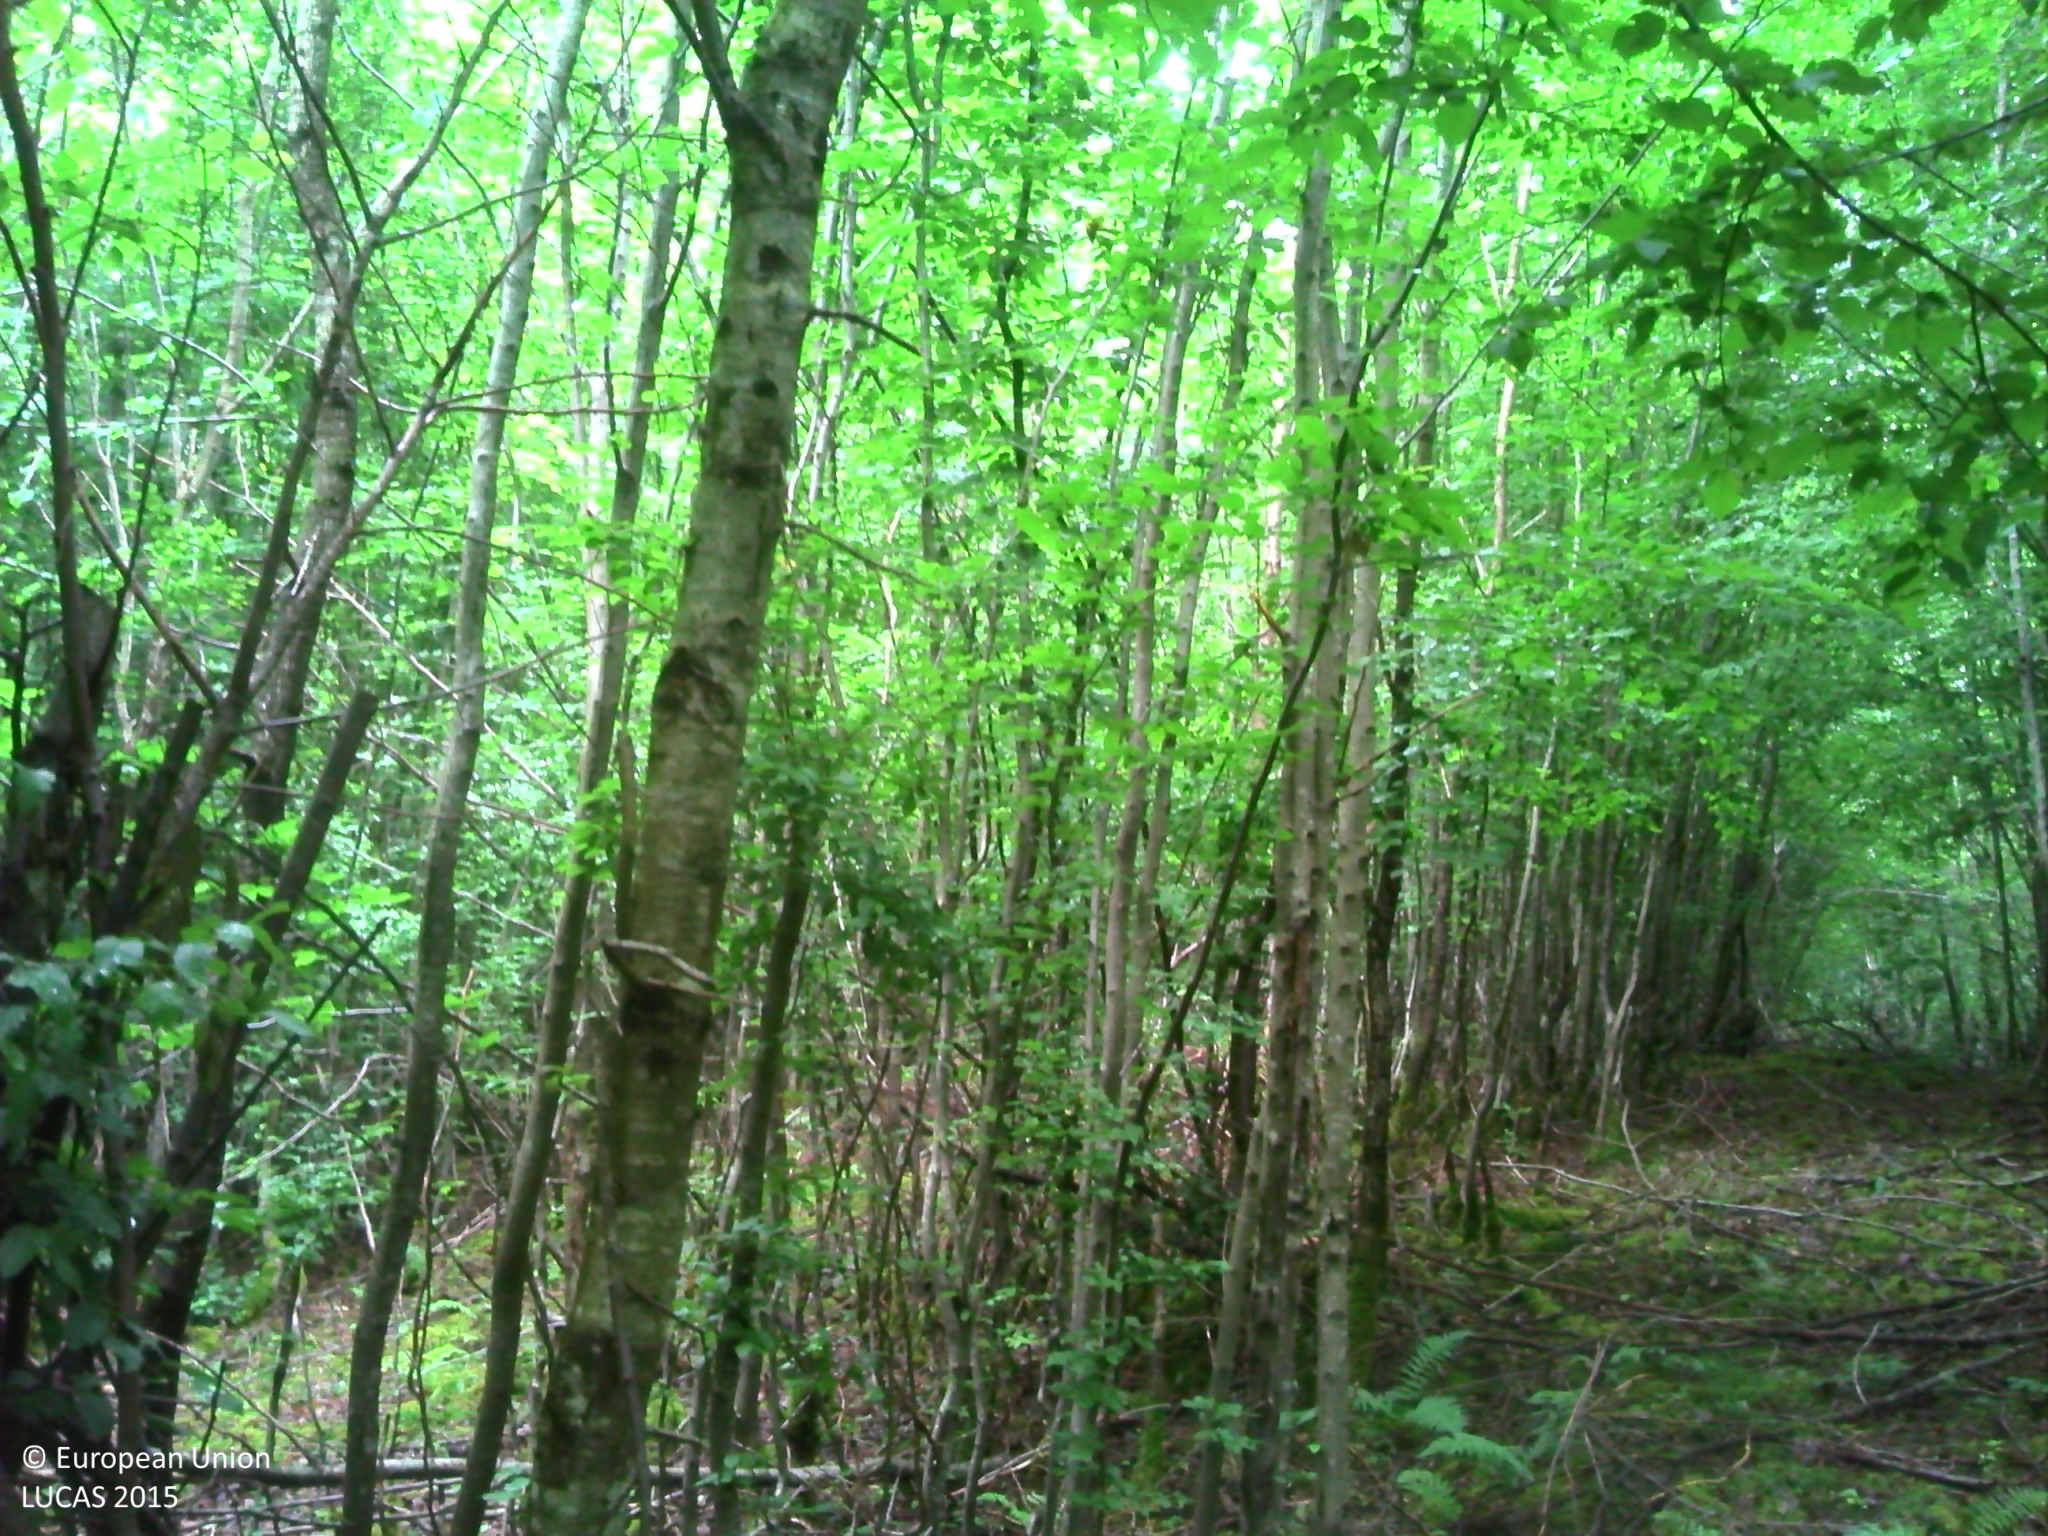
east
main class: Woodland
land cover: Broadleaved woodland
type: mesophytic deciduous forest
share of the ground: > 75 %
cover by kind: broadleaved forest trees 90 %, herbaceous plants 5 %, lichens and mosses 5 %
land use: Forestry
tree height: > 5 m
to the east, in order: Broadleaved woodland; Ditches and canals; Grass margins; Paved roads, cycling and walking lanes; Grass margins; Ditches and canals; Broadleaved woodland
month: June
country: FR
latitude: 47.3065
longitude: 3.1572
